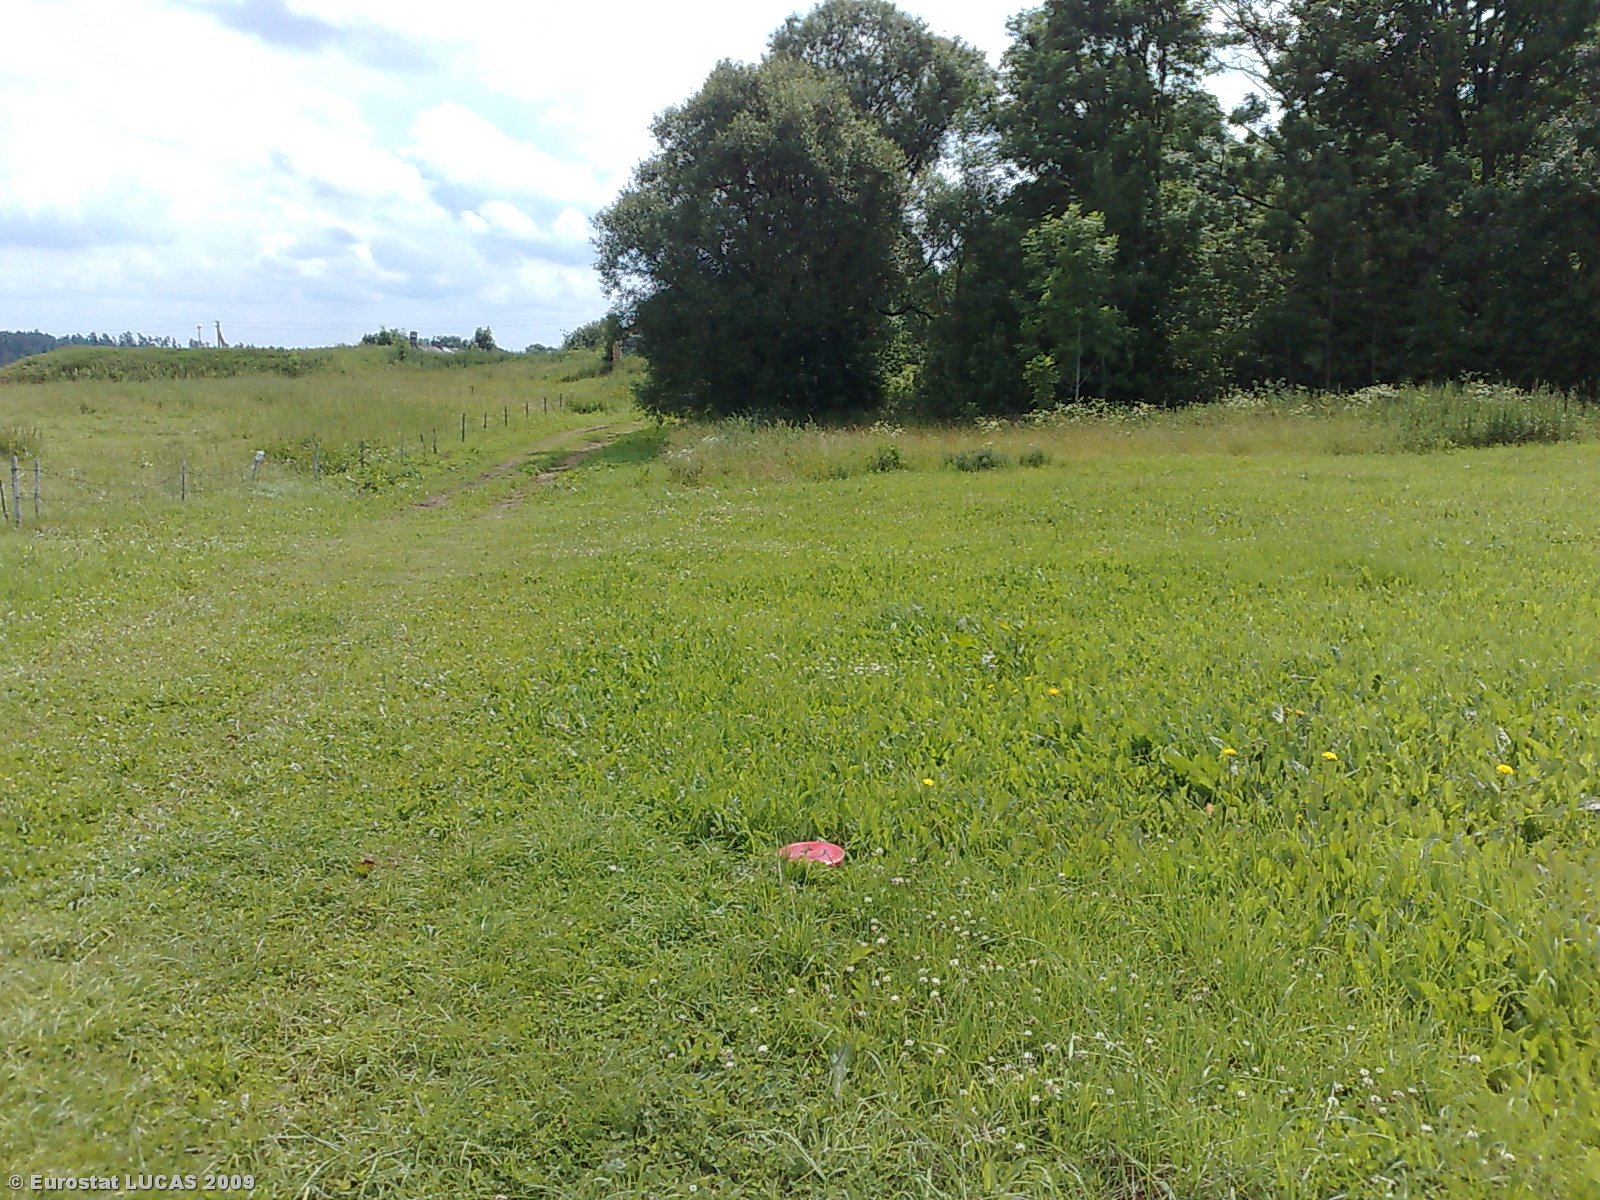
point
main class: Grassland
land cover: Grassland without tree/shrub cover
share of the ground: > 75 %
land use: Agriculture (excluding fallow land and kitchen gardens)
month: July
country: LT
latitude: 55.5826
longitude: 22.7724
